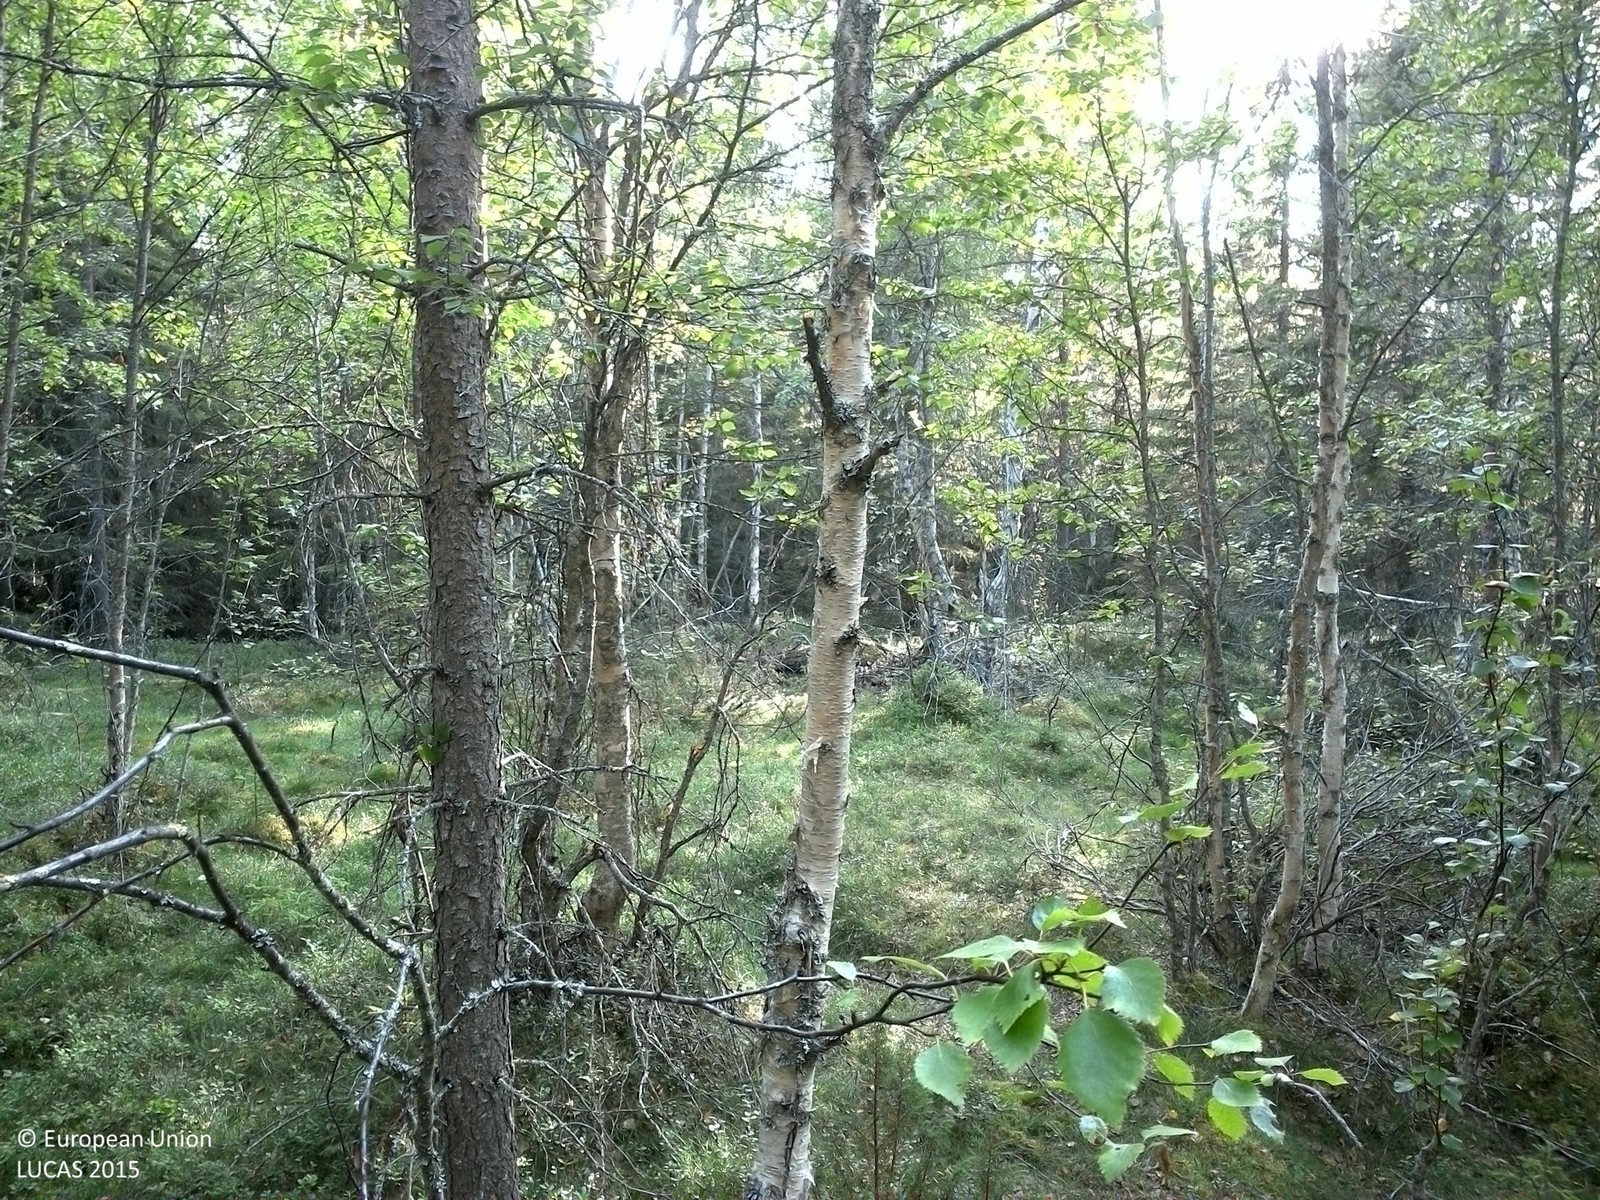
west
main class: Woodland
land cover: Other mixed woodland
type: boreal forest
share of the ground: > 75 %
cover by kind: coniferous forest trees 40 %, broadleaved forest trees 35 %, shrubs 20 %, lichens and mosses 5 %
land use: Forestry
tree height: > 5 m
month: August
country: SE
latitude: 63.8627
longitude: 17.3978
